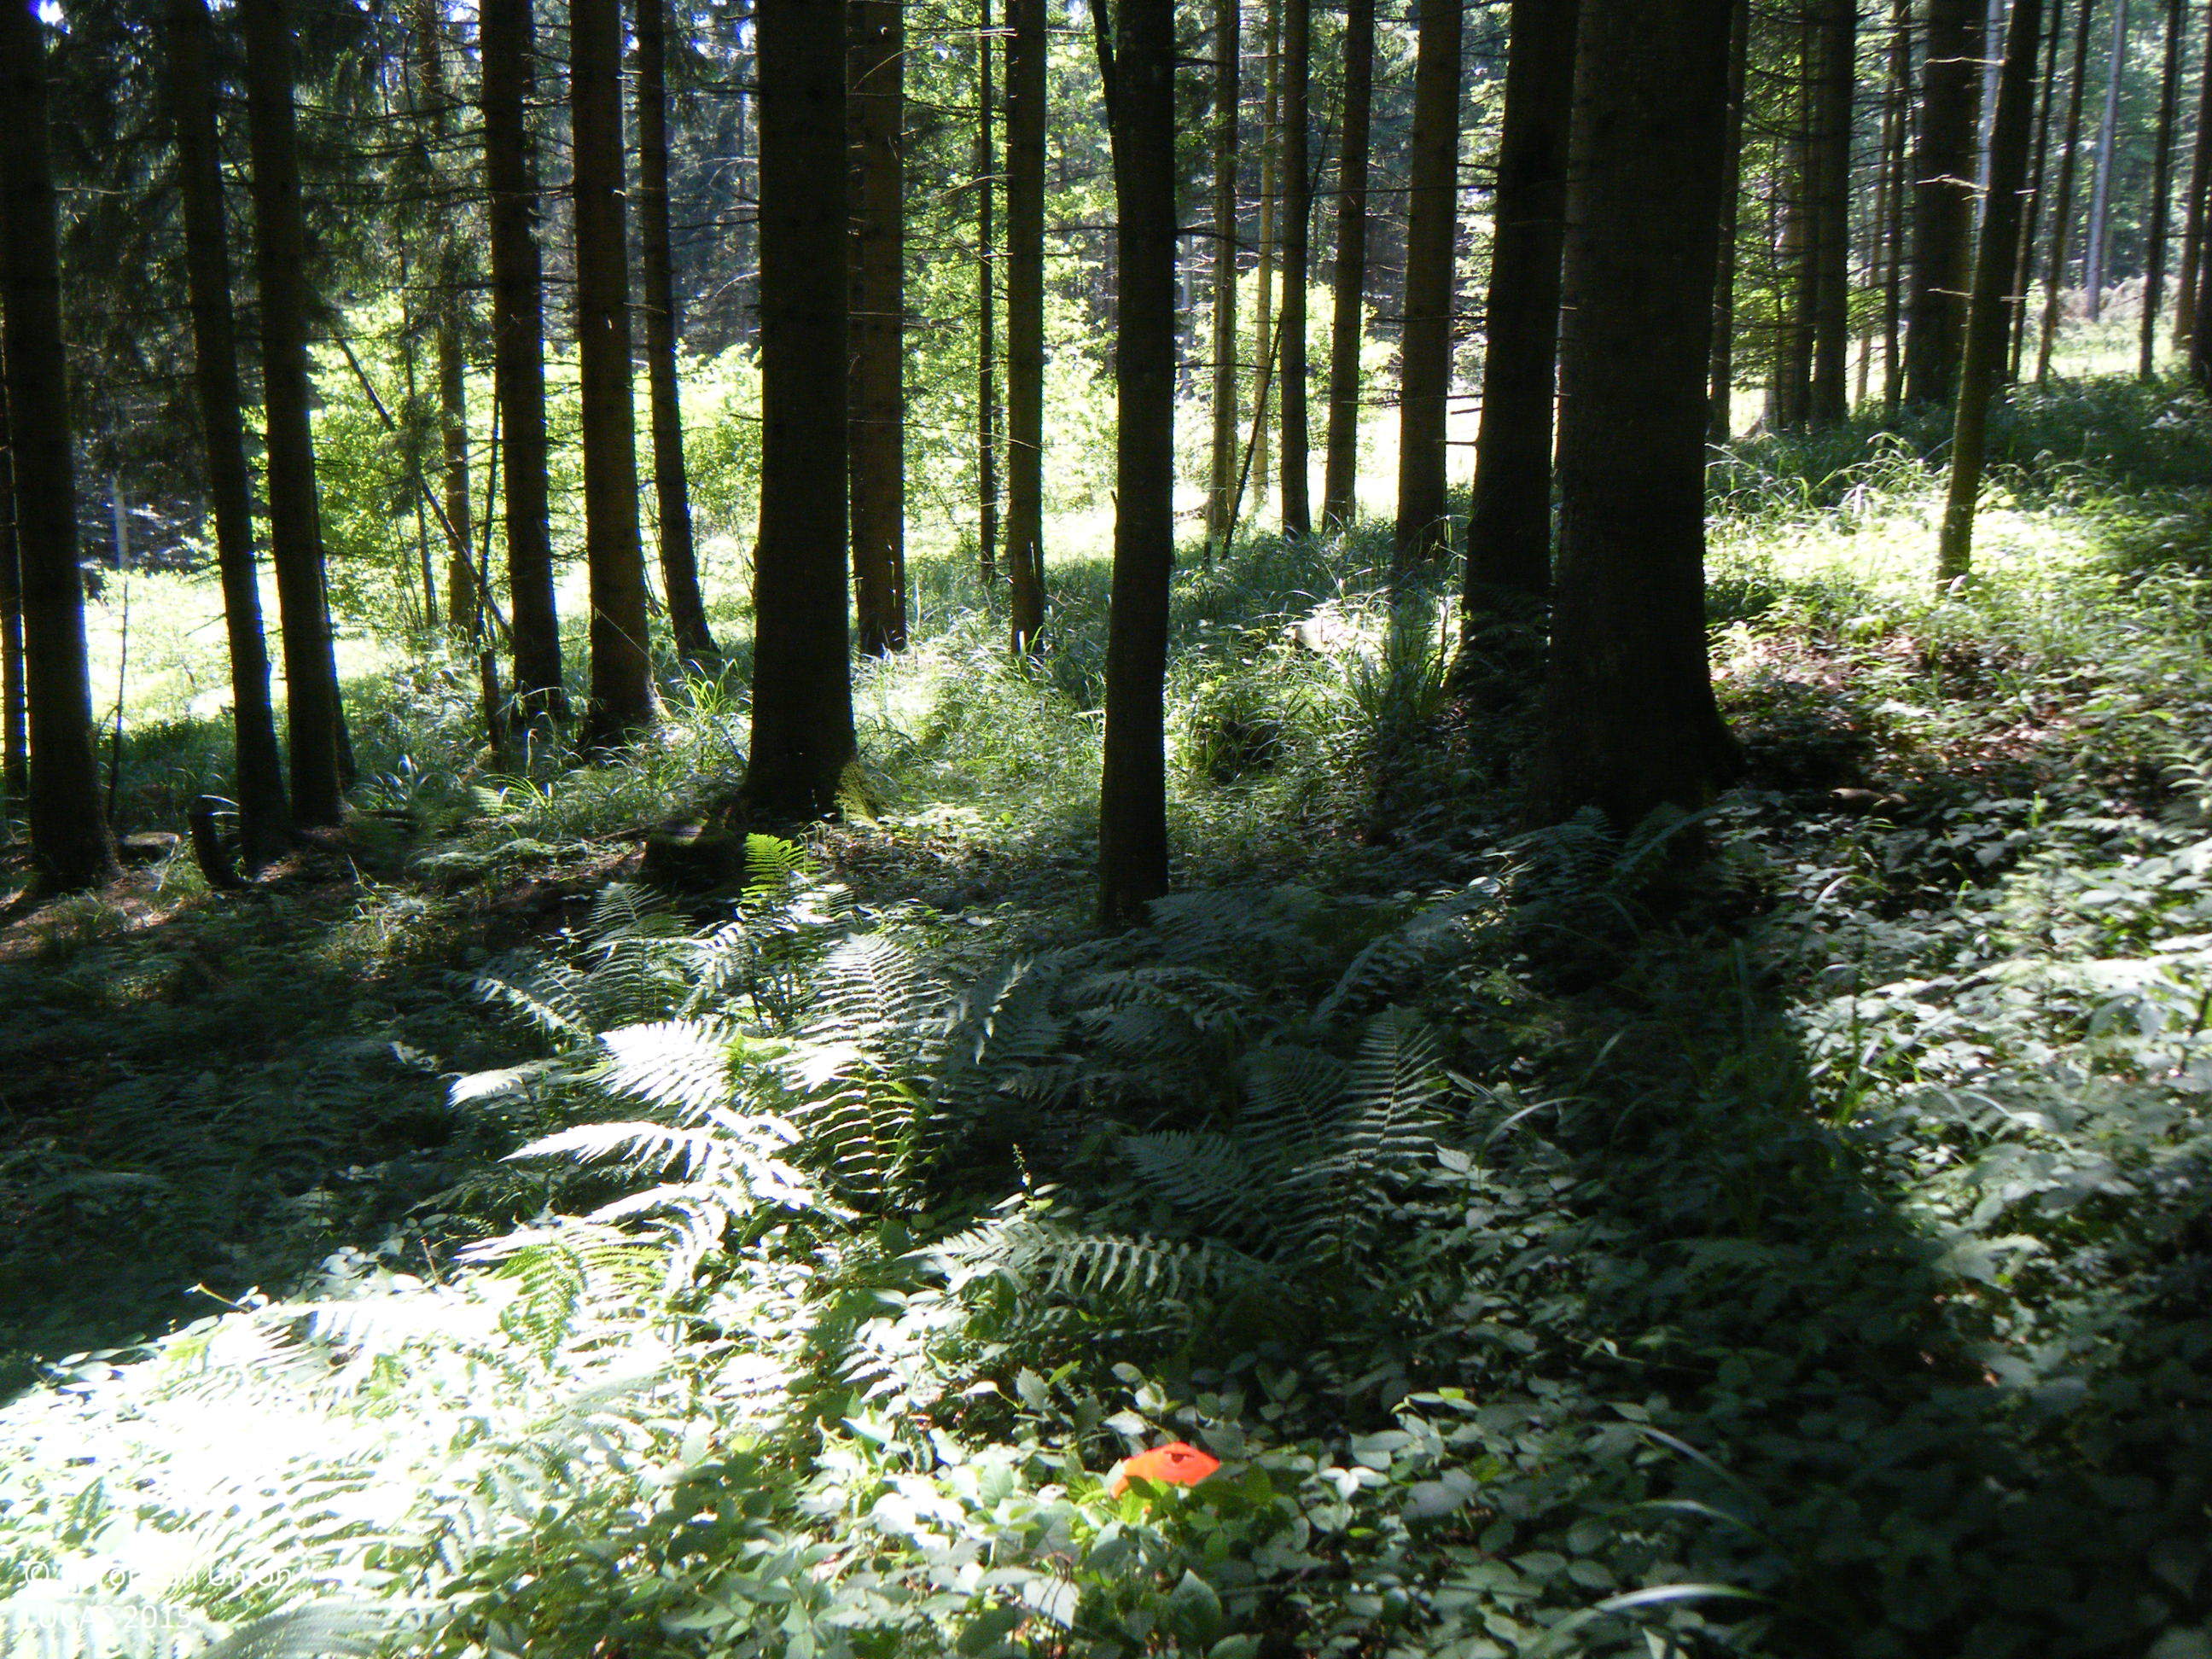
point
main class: Woodland
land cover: Spruce dominated mixed woodland
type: alpine coniferous forest
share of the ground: > 75 %
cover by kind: coniferous forest trees 65 %, broadleaved forest trees 25 %, herbaceous plants 10 %
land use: Forestry
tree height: > 5 m
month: July
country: AT
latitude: 47.8622
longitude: 13.4877
